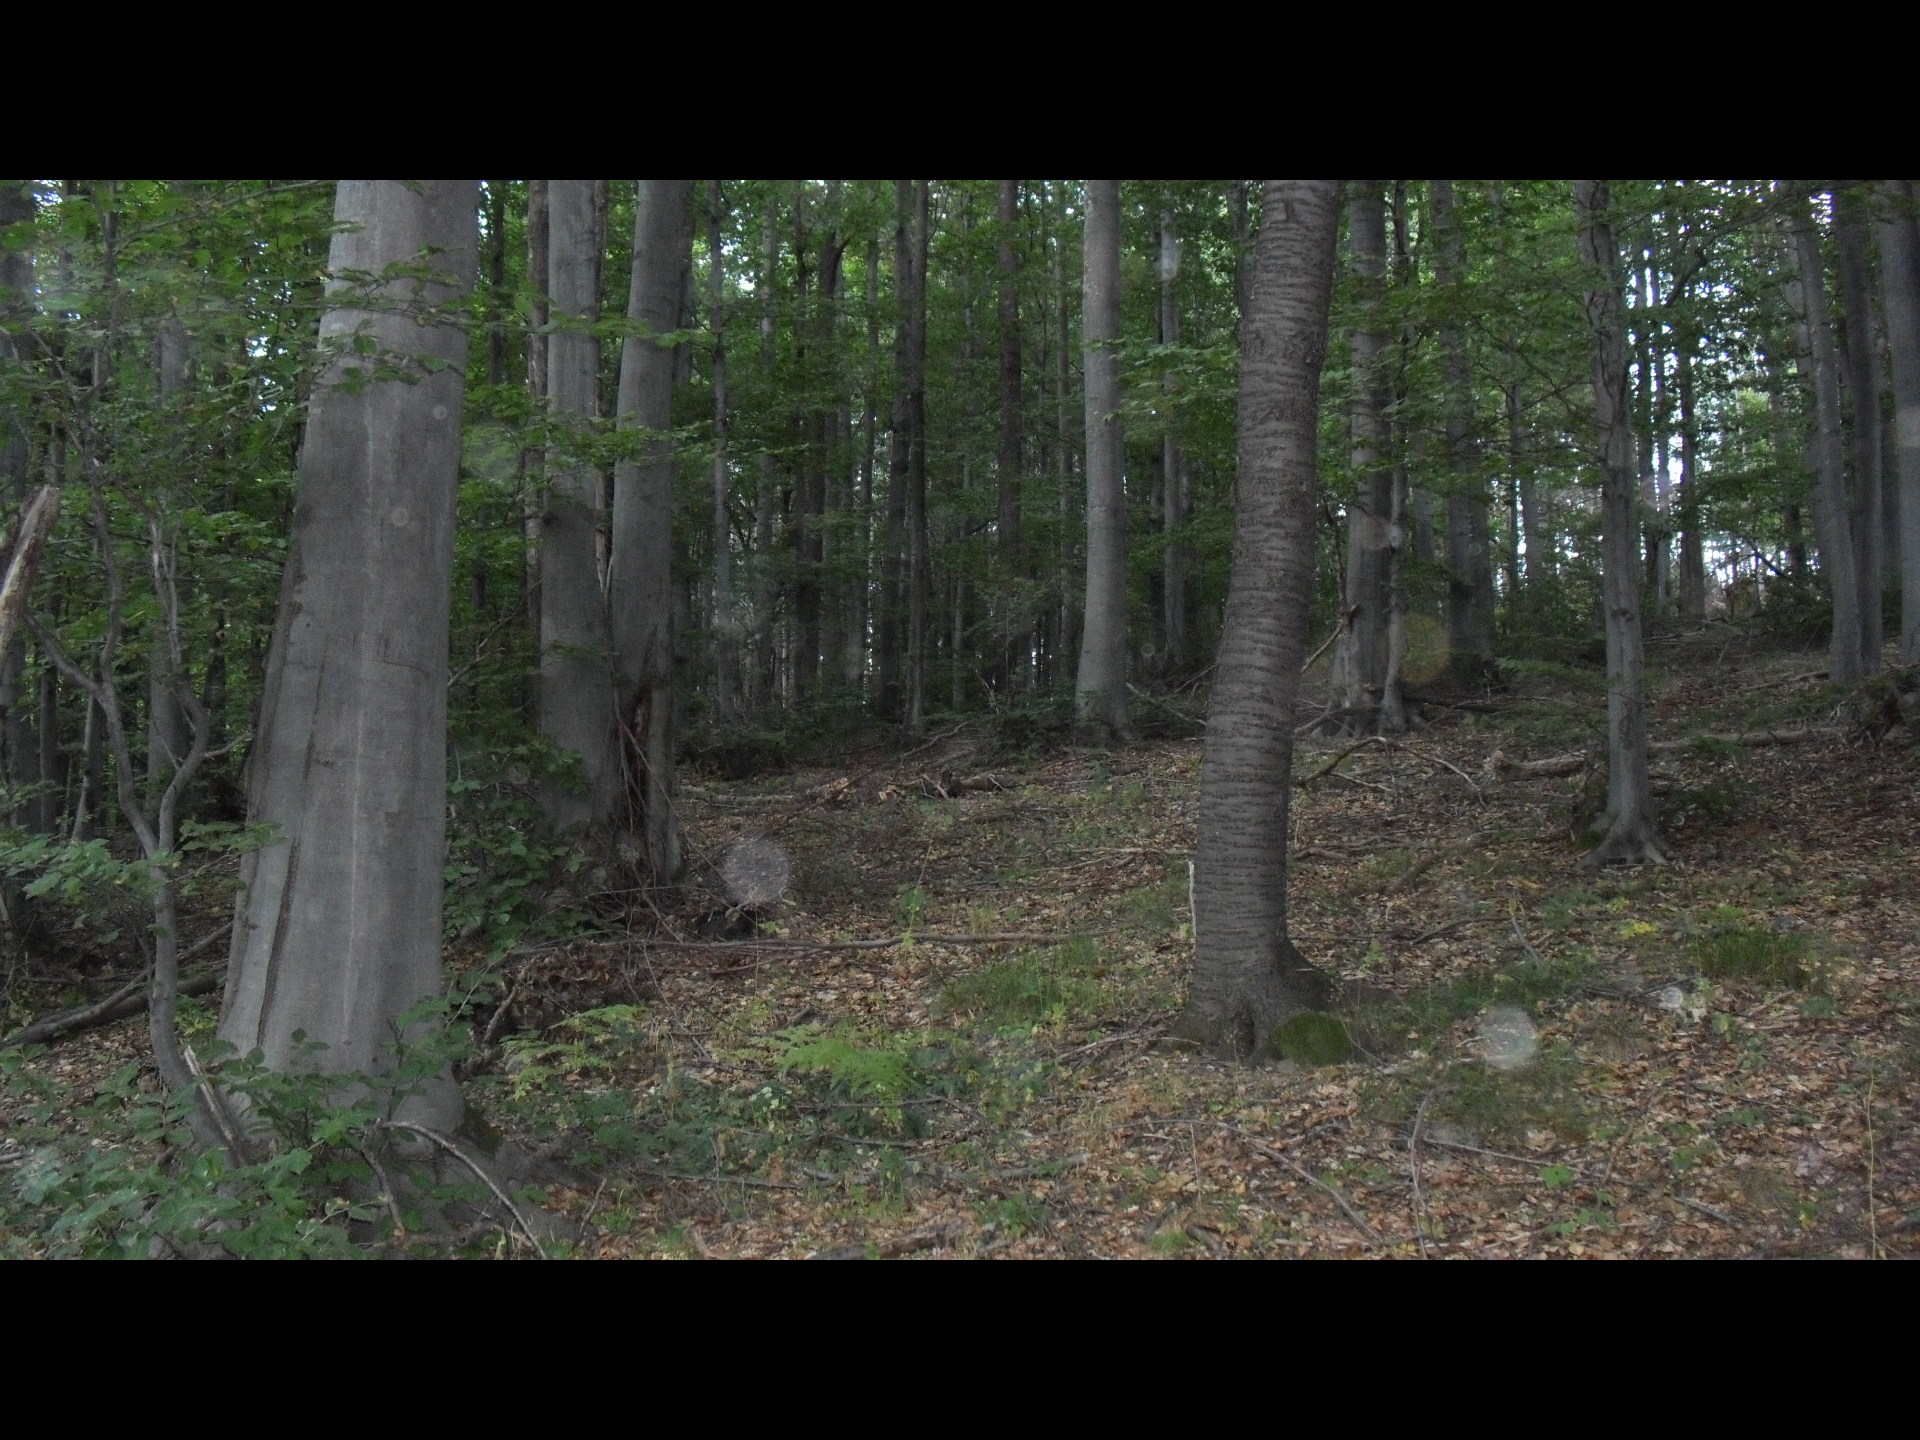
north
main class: Woodland
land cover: Broadleaved woodland
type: beech forest
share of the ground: > 75 %
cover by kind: broadleaved forest trees 95 %, unconsolidated bare surface 5 %
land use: Forestry
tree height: > 5 m
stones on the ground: < 10 %
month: August
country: BG
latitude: 43.2450
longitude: 23.0784
